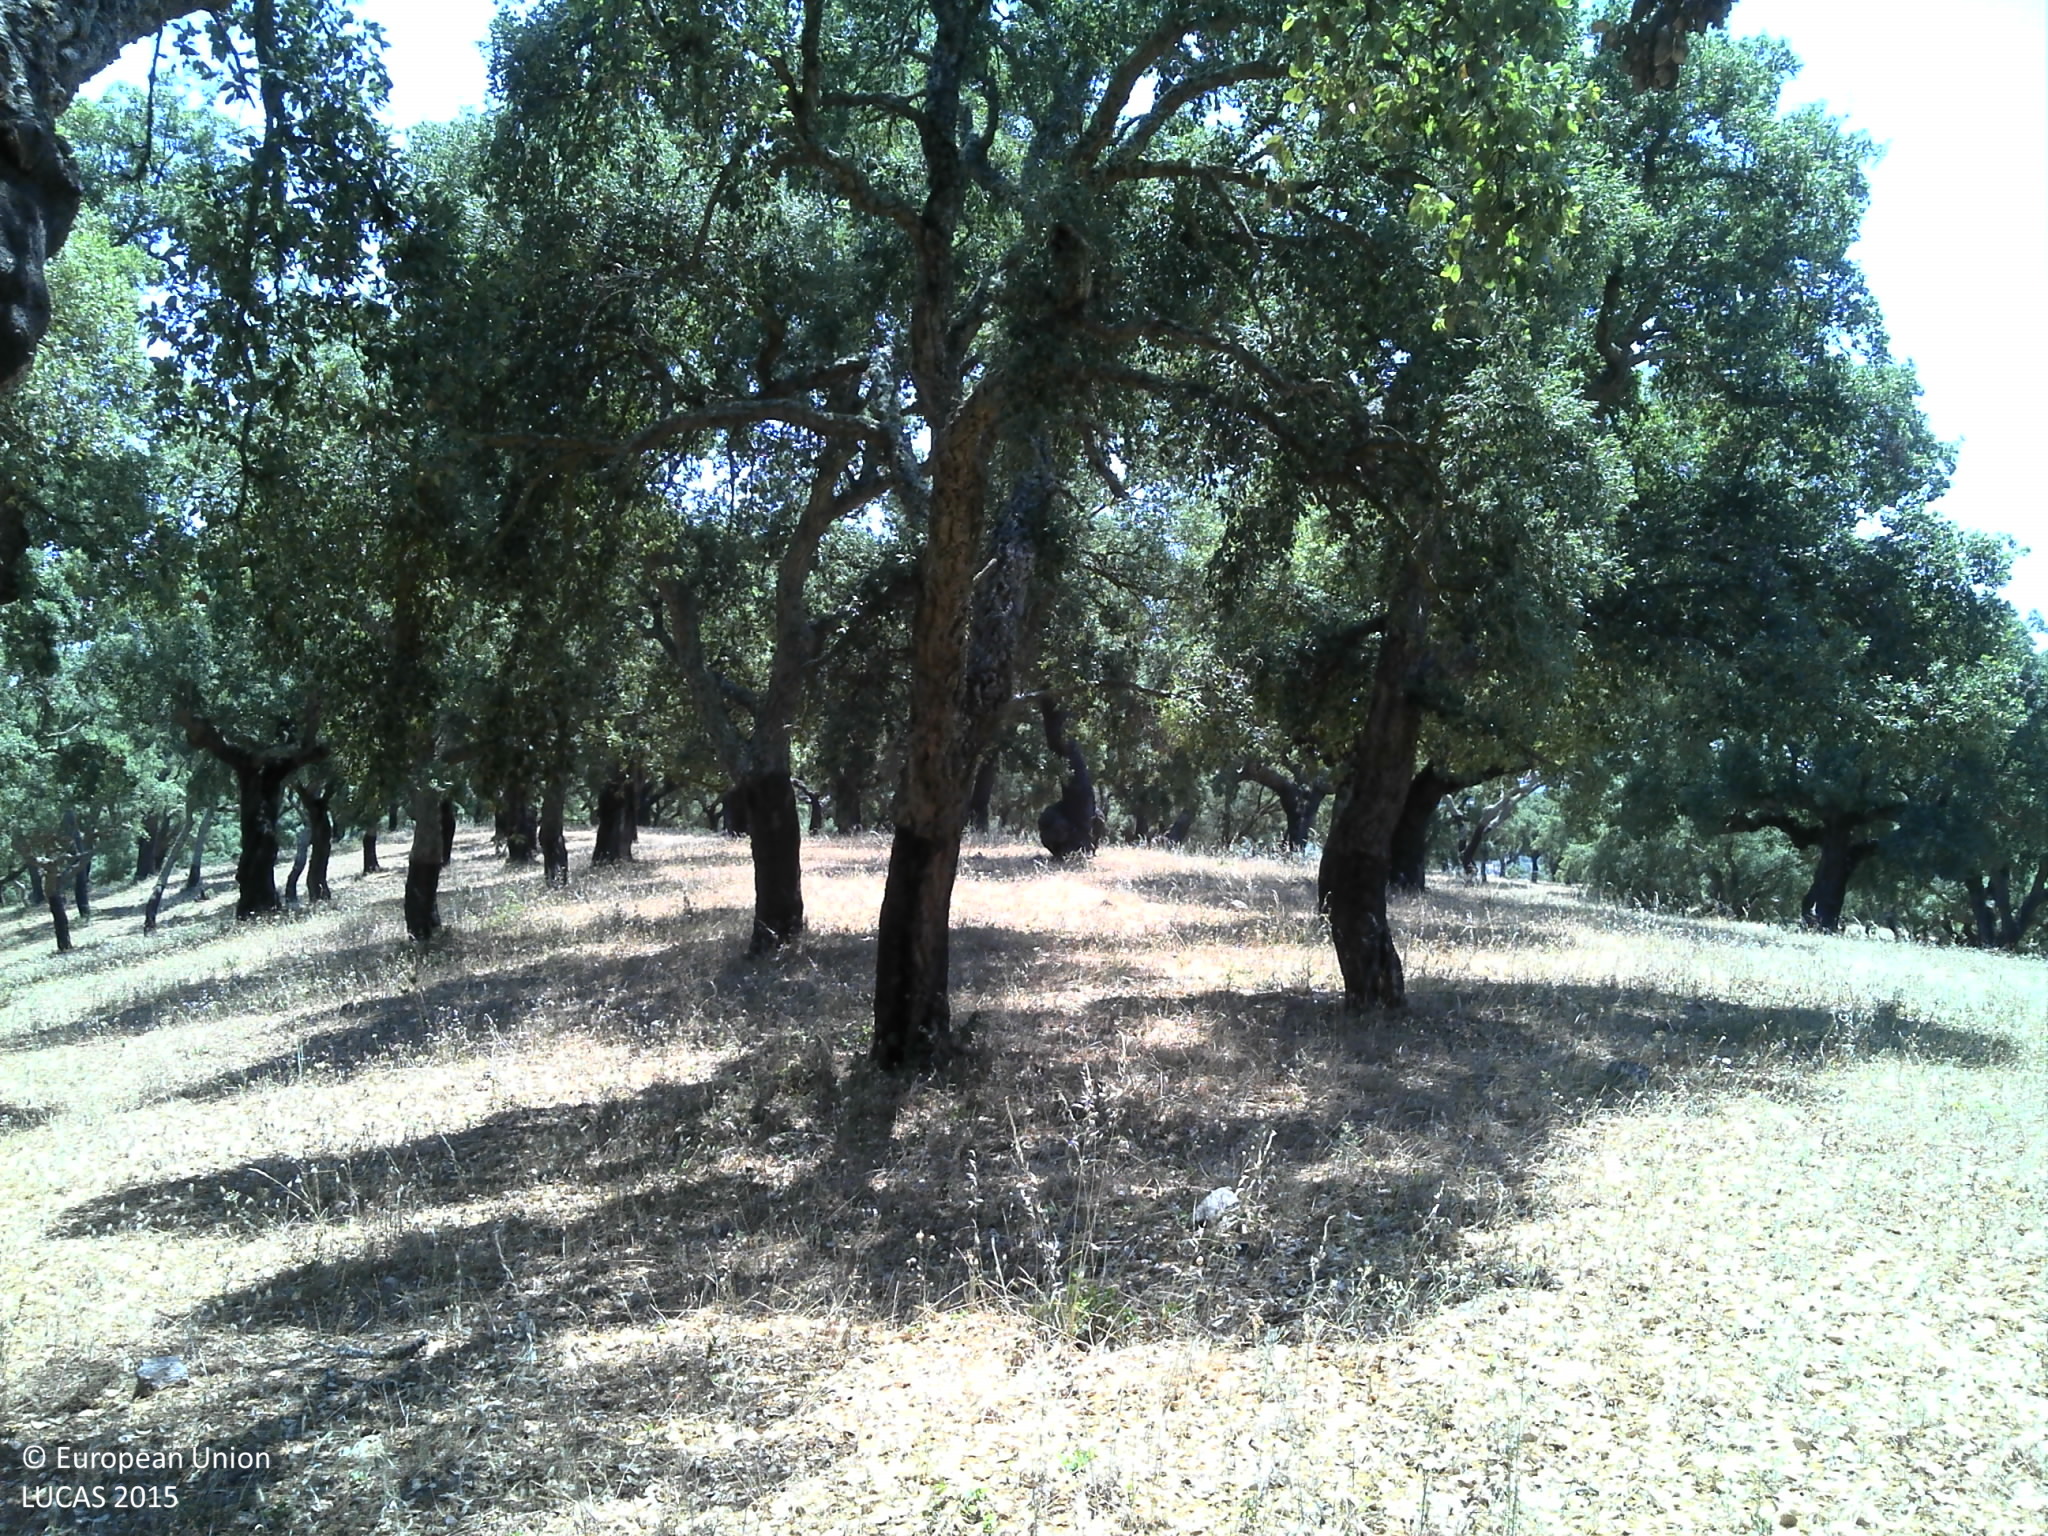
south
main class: Woodland
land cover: Broadleaved woodland
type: broadleaved evergreen forest
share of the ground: 50 - 75 %
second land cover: Grassland without tree/shrub cover
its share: 10 - 25 %
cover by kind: broadleaved forest trees 75 %, unconsolidated bare surface 15 %, herbaceous plants 10 %
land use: Forestry
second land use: Agriculture (excluding fallow land and kitchen gardens)
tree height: > 5 m
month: June
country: PT
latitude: 38.6124
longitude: -8.1571
